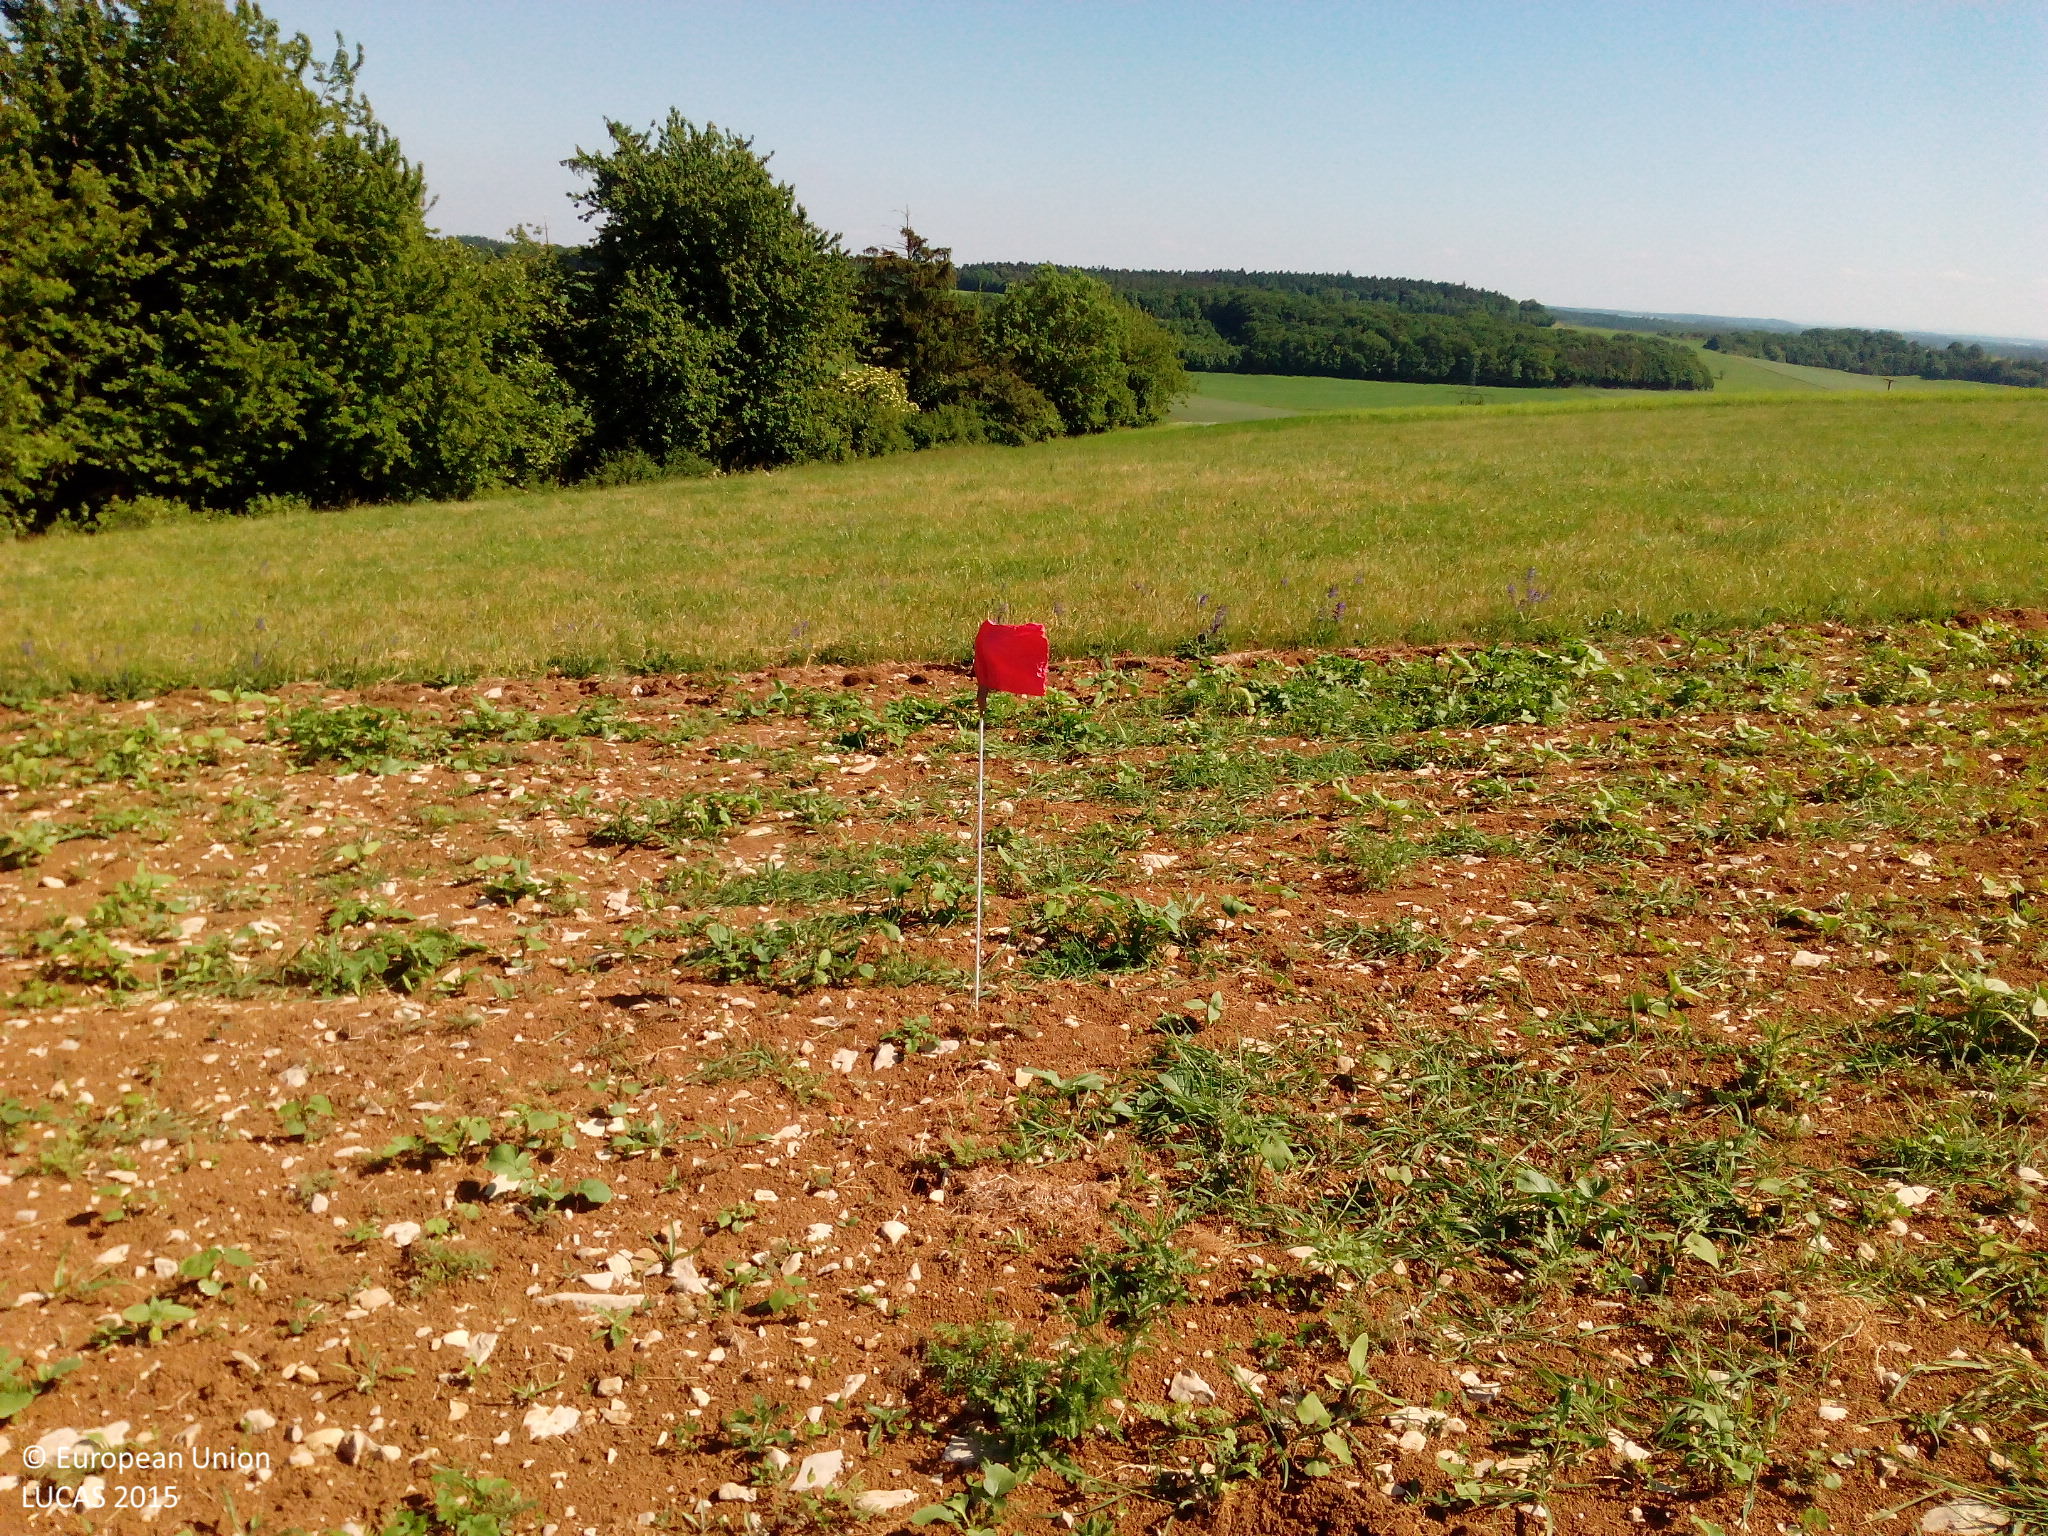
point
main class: Cropland
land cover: Other cereals
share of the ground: 25 - 50 %
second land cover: Other leguminous and mixtures for fodder
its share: 10 - 25 %
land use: Agriculture (excluding fallow land and kitchen gardens)
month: June
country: DE
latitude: 49.5173
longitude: 9.4063
